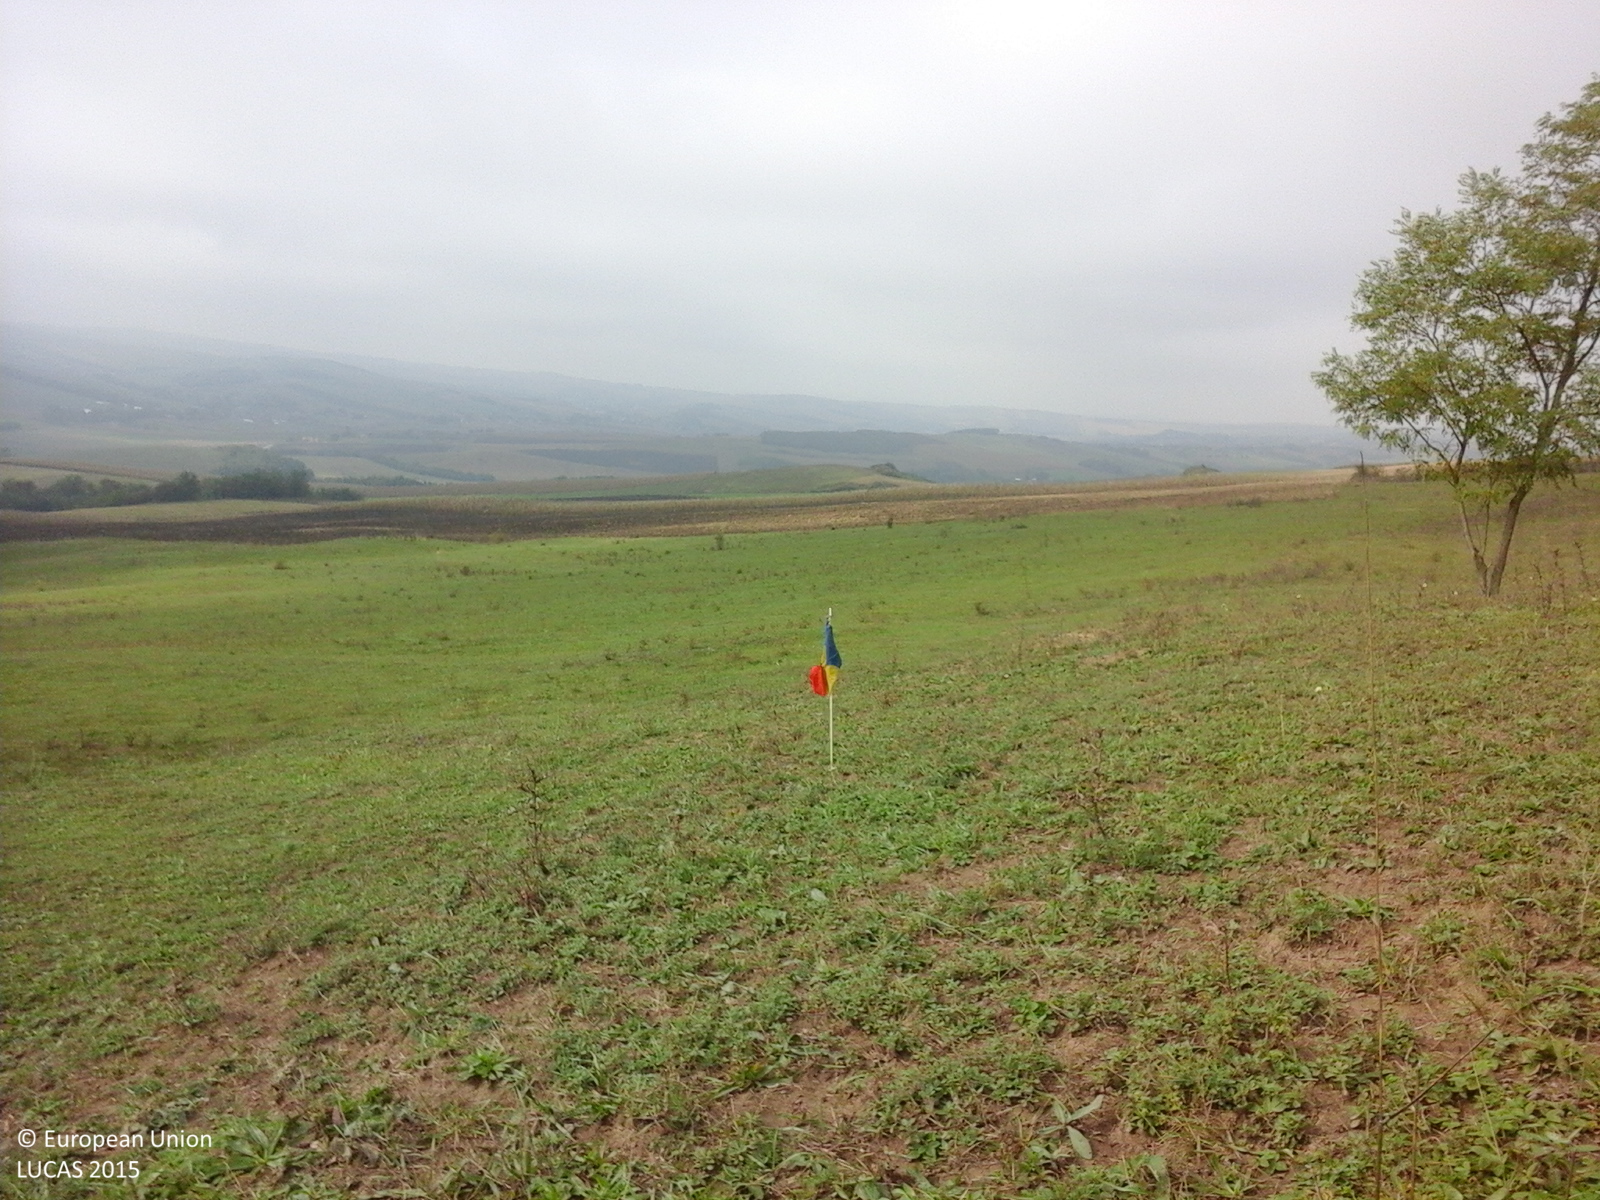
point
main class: Grassland
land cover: Grassland without tree/shrub cover
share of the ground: > 75 %
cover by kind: herbaceous plants 100 %
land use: Agriculture (excluding fallow land and kitchen gardens)
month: October
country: RO
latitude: 46.6371
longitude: 24.3629
